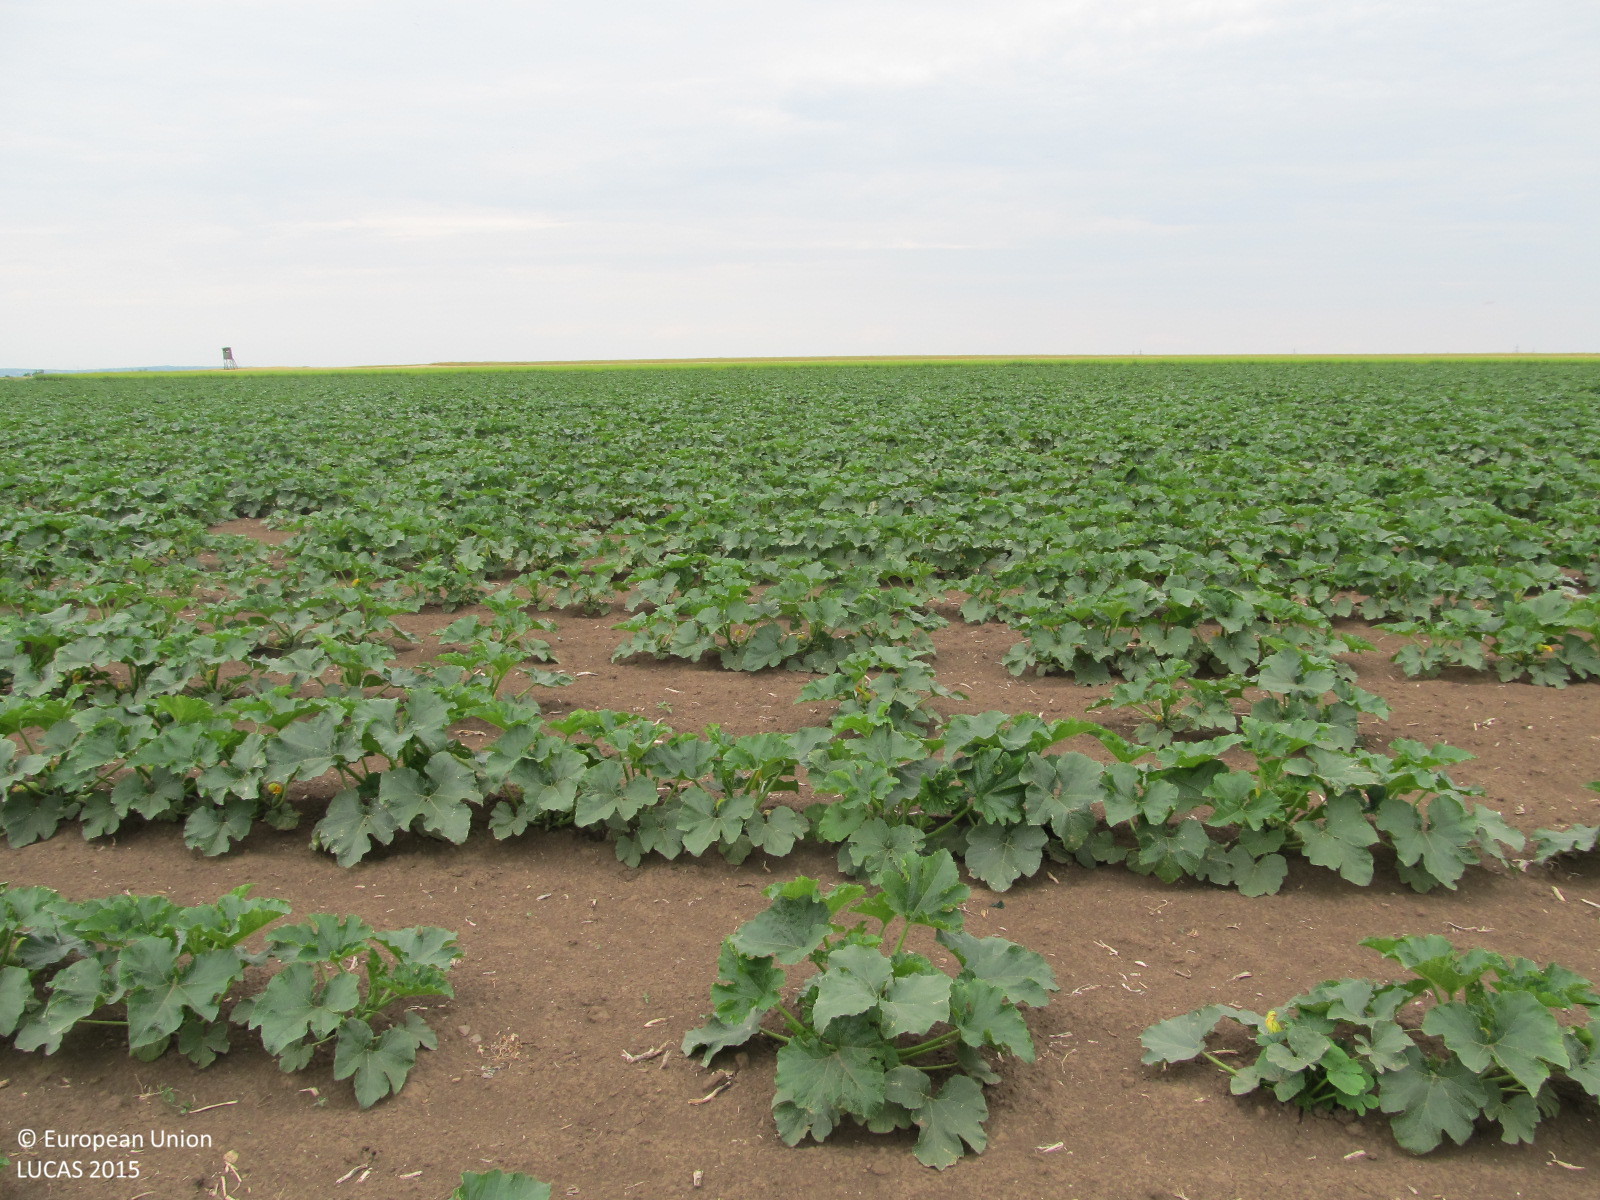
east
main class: Cropland
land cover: Other fibre and oleaginous crops
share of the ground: 25 - 50 %
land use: Agriculture (excluding fallow land and kitchen gardens)
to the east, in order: Other fibre and oleaginous crops; Rape and turnip rape; Barley; Soya
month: June
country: AT
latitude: 48.6783
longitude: 15.9121
